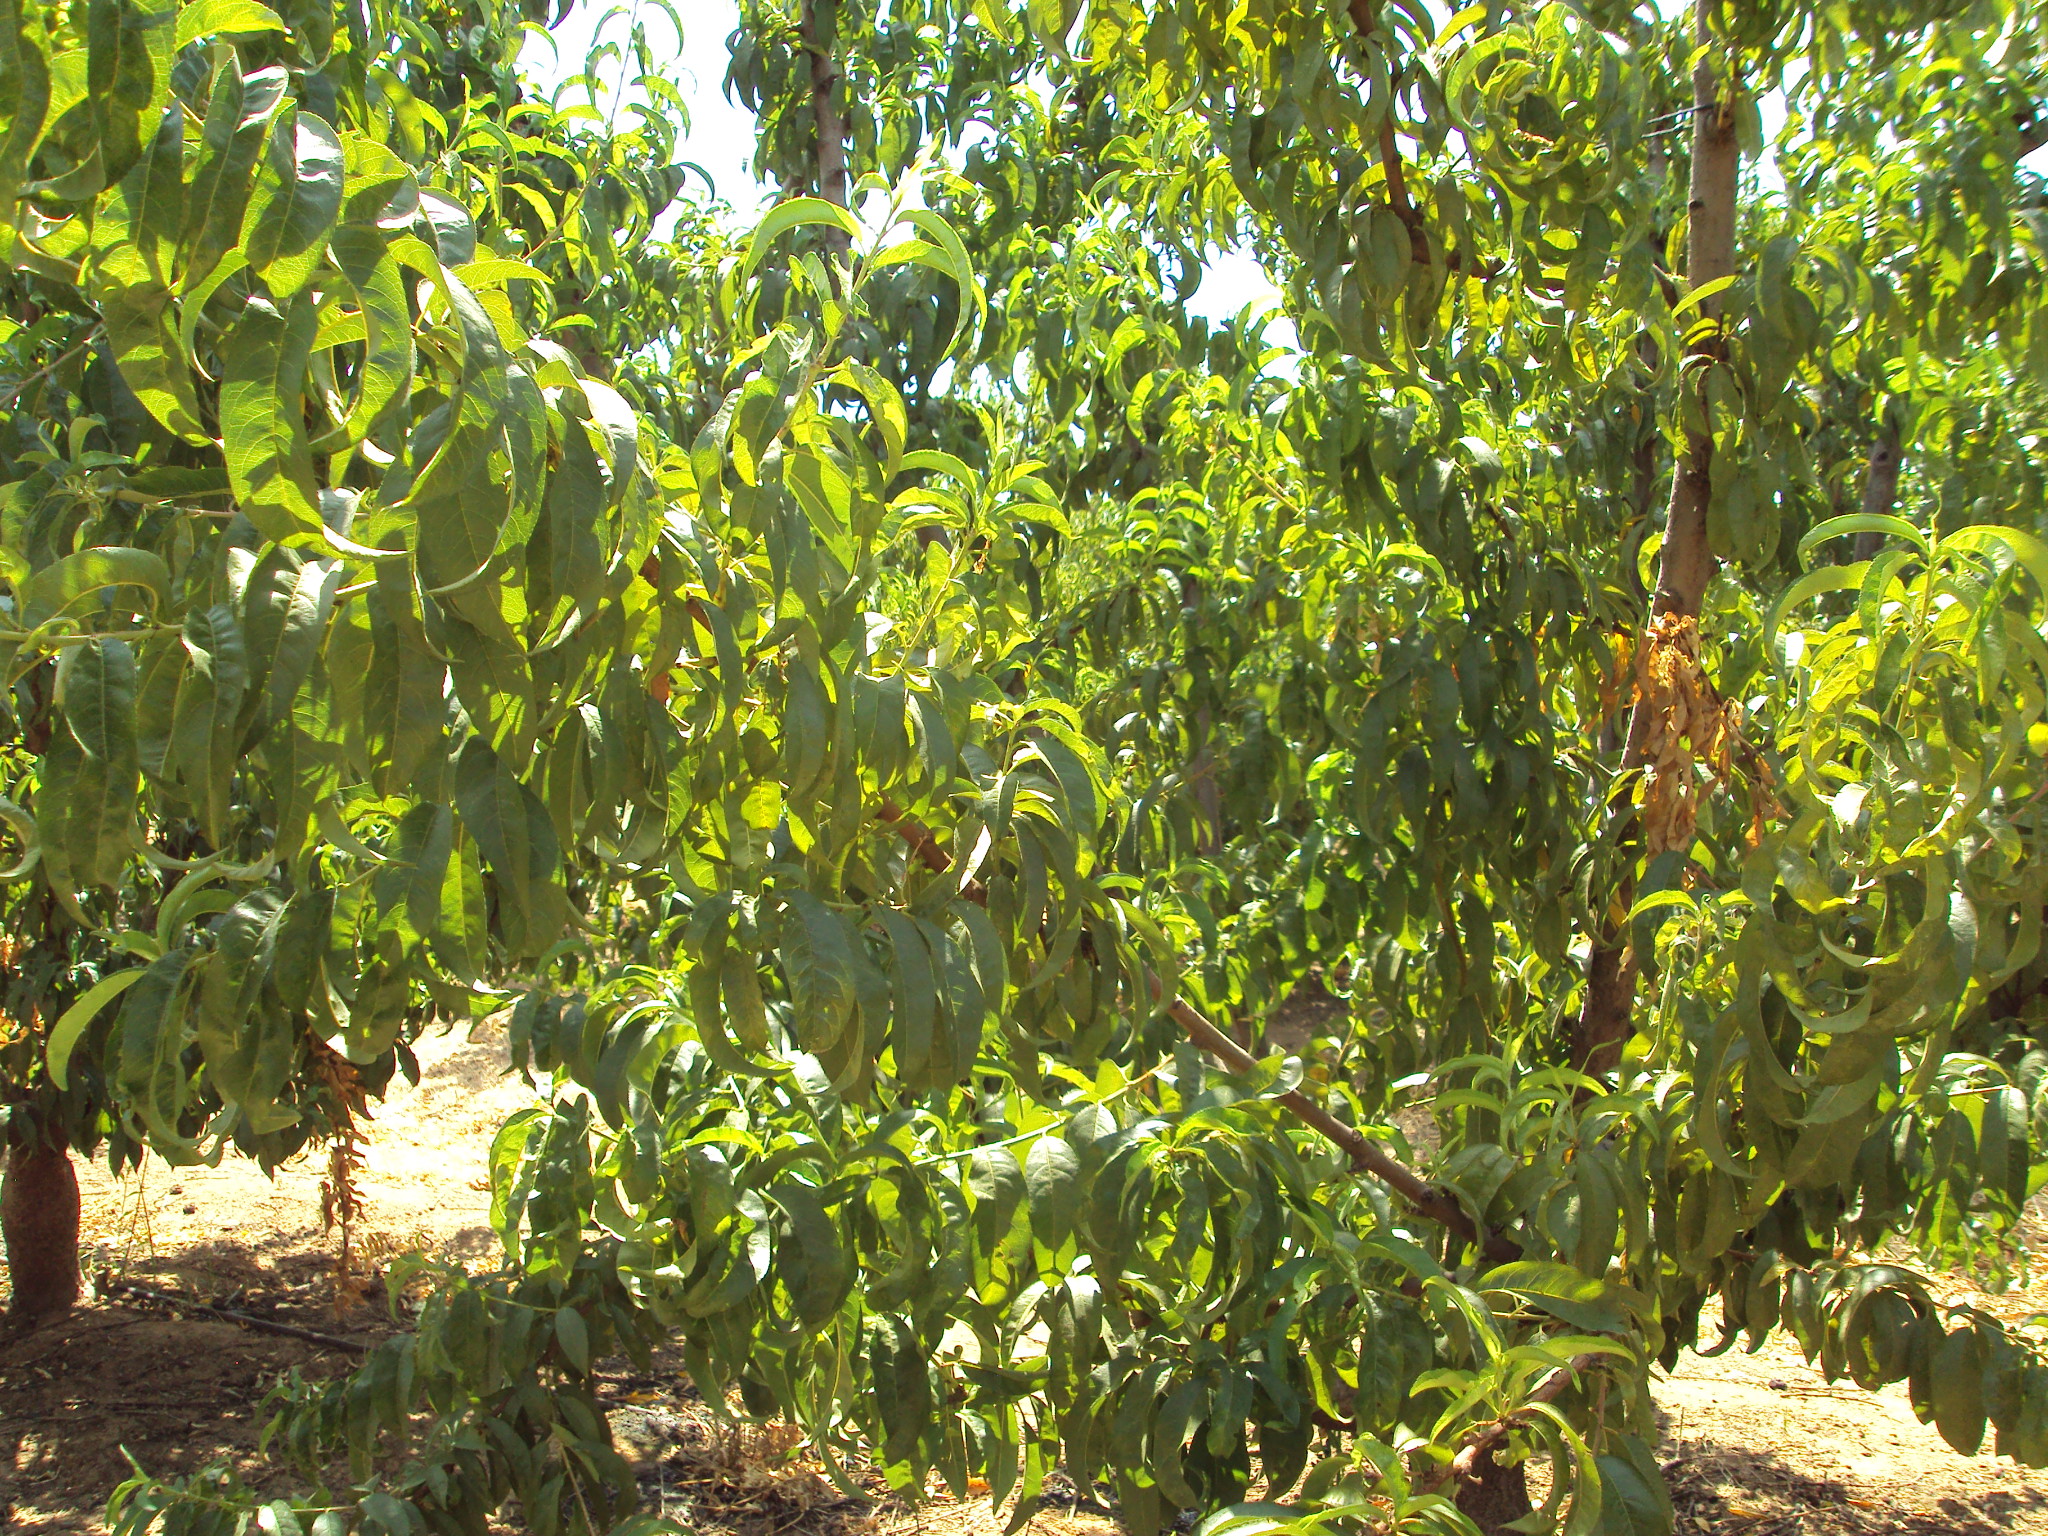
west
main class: Cropland
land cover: Other fruit trees and berries
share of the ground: 50 - 75 %
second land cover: Spontaneously vegetated surfaces
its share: > 75 %
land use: Agriculture (excluding fallow land and kitchen gardens)
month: July
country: ES
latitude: 37.3800
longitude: -7.0392
